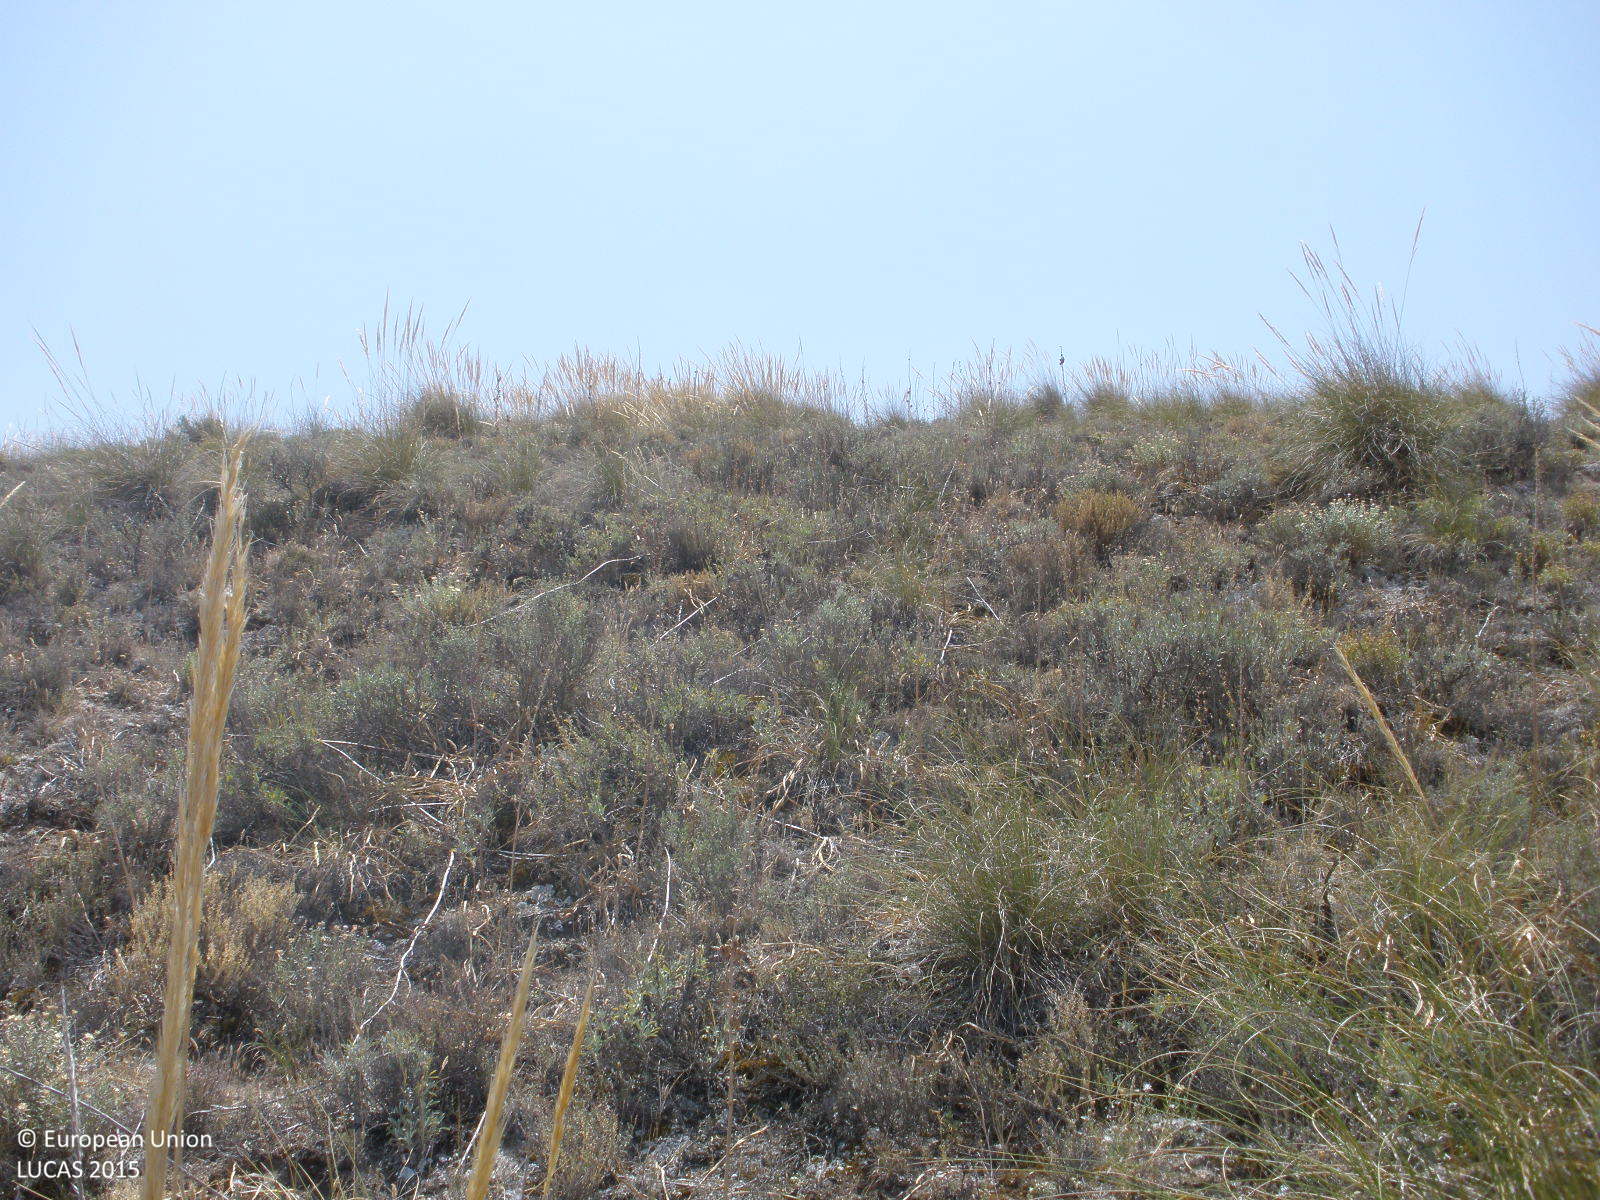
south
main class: Shrubland
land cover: Shrubland without tree cover
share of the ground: 25 - 50 %
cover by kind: herbaceous plants 50 %, shrubs 40 %, consolidated bare surface 10 %
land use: Semi-natural and natural areas not in use
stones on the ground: < 10 %
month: July
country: ES
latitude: 40.0352
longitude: -3.1632
